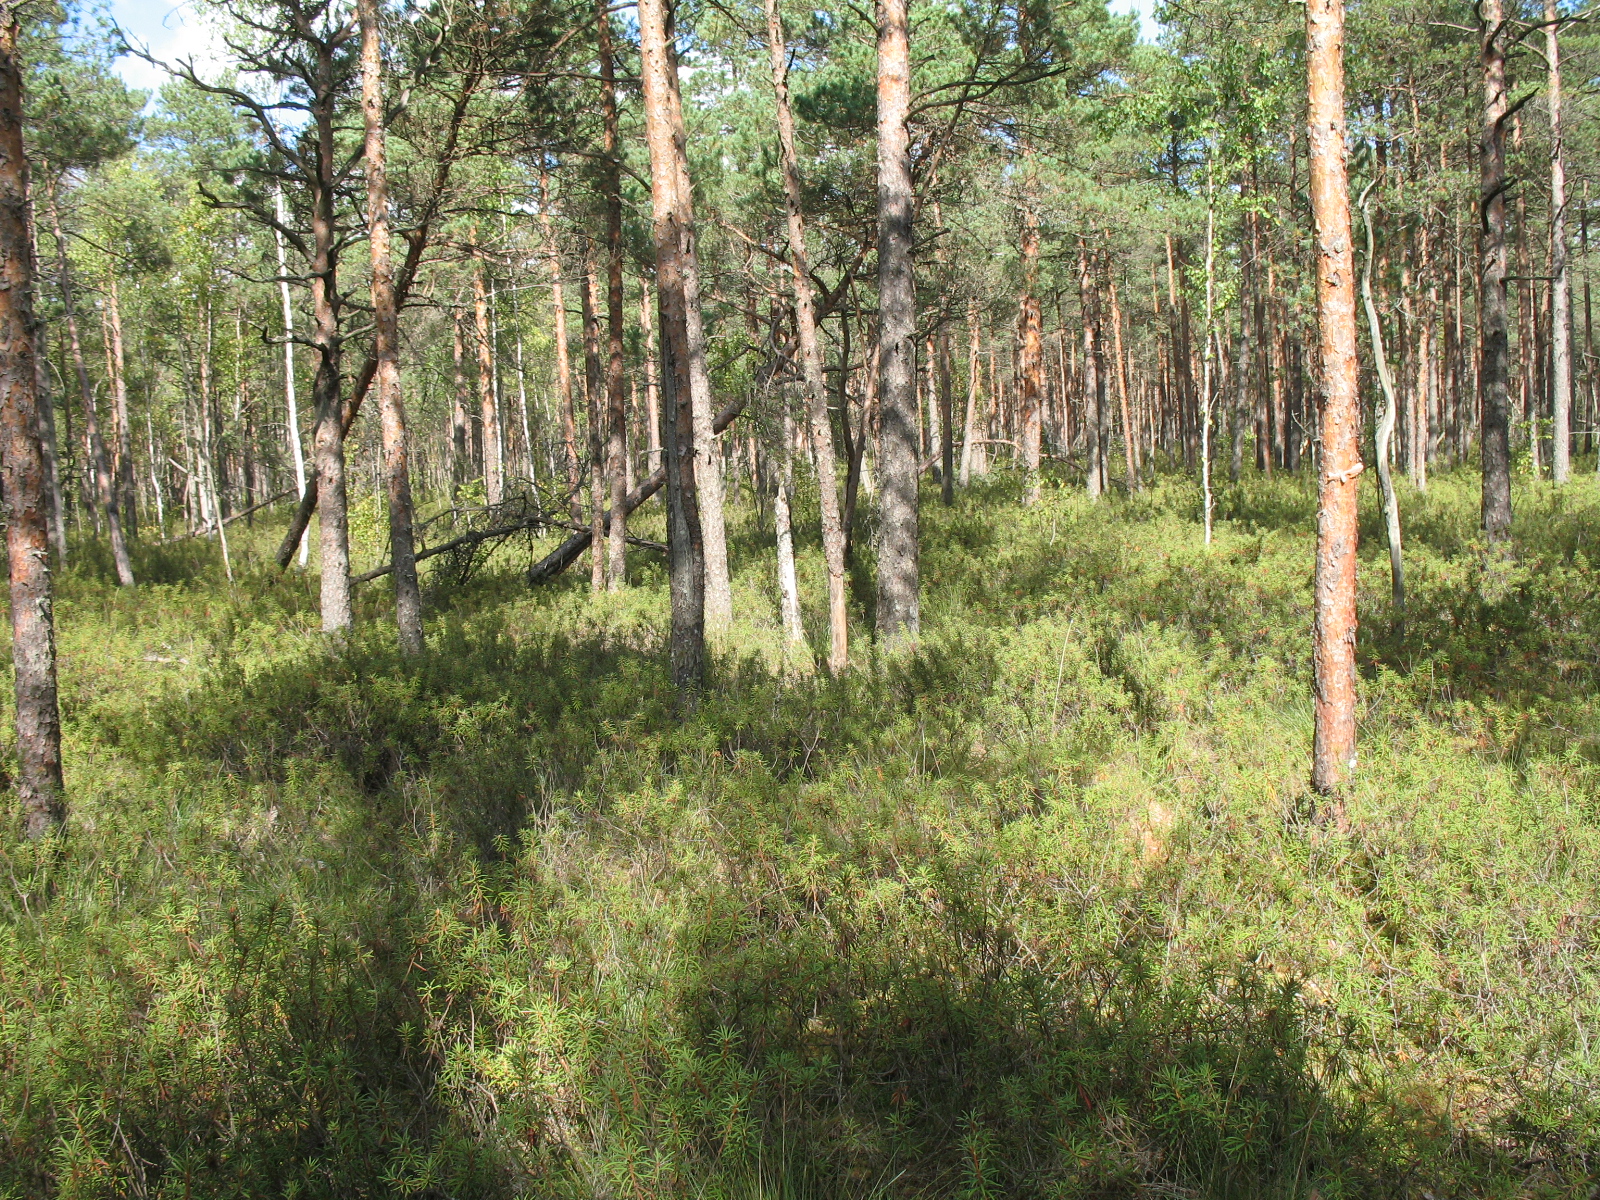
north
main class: Woodland
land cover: Pine dominated coniferous woodland
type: hemiboreal forest and nemoral coniferous forest and mixed broadleaved-coniferous forest
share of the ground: 25 - 50 %
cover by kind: coniferous forest trees 40 %, lichens and mosses 30 %, herbaceous plants 15 %, shrubs 10 %, broadleaved forest trees 5 %
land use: Forestry
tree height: > 5 m
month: September
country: LV
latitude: 56.1631
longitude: 25.4337
